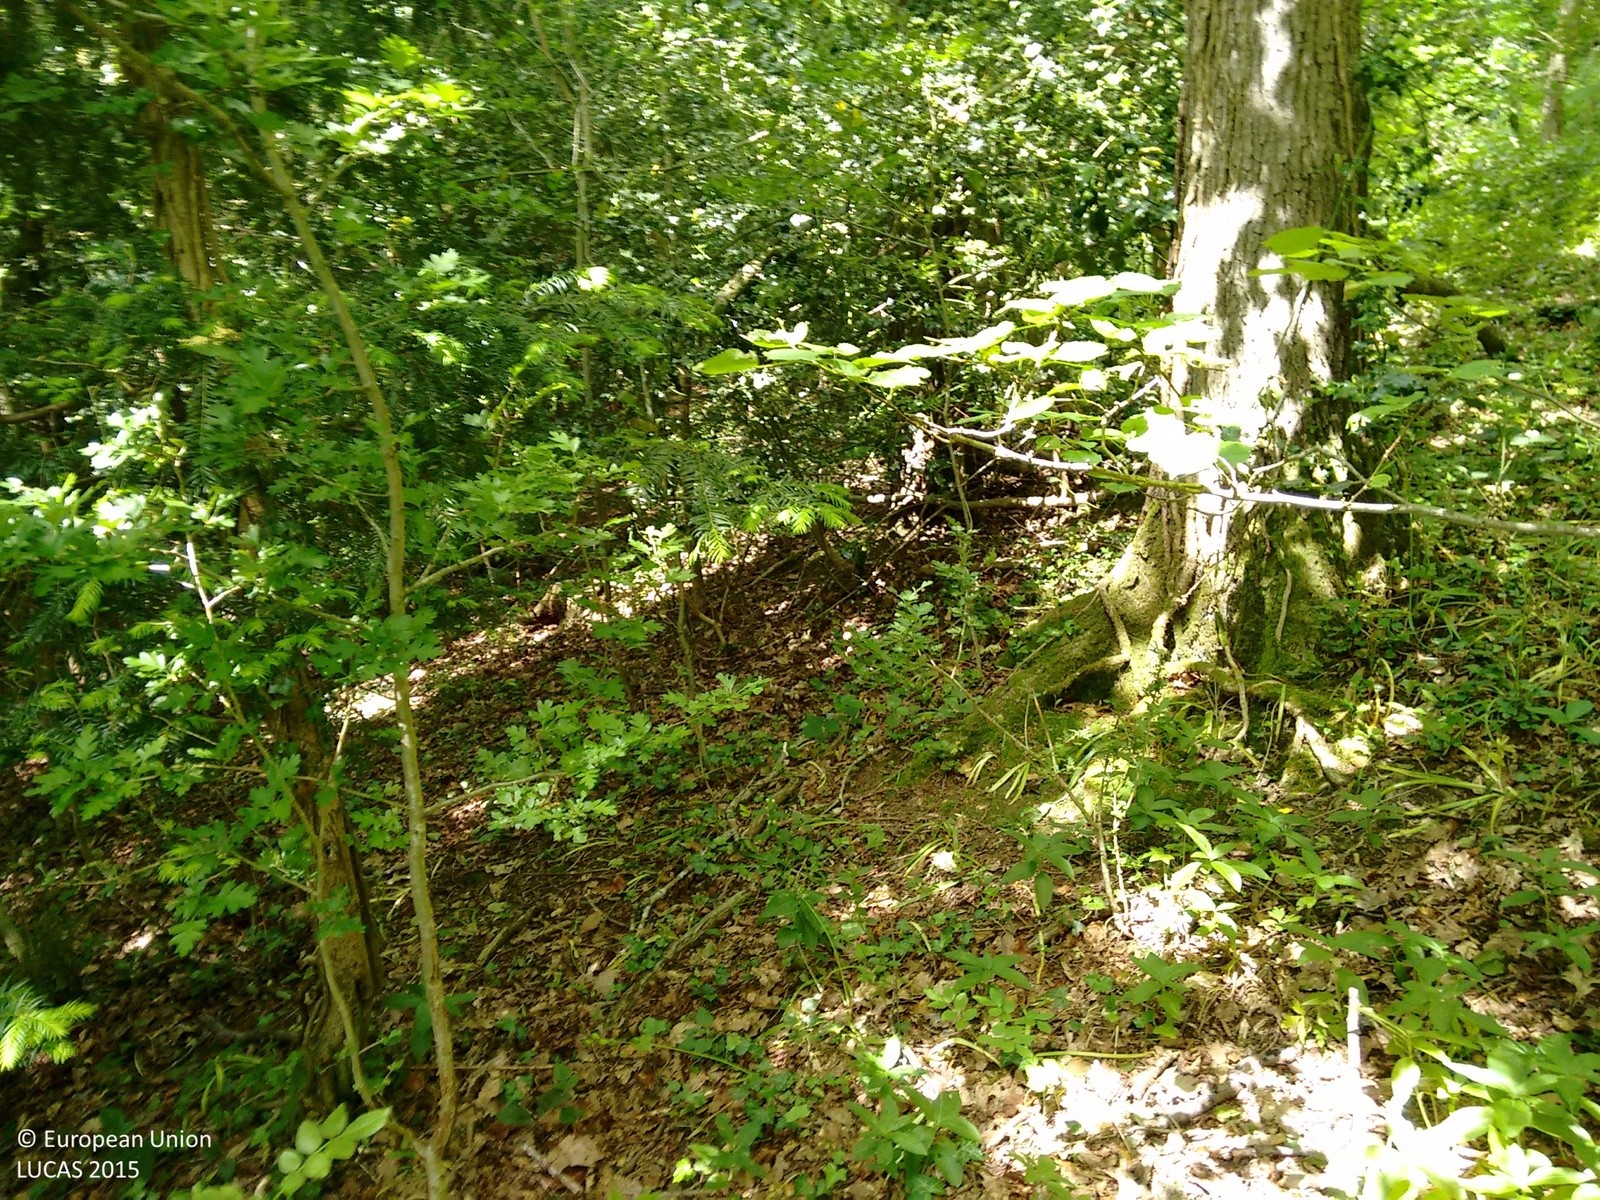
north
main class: Woodland
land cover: Broadleaved woodland
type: mesophytic deciduous forest
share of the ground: > 75 %
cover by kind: broadleaved forest trees 100 %
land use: Semi-natural and natural areas not in use
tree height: > 5 m
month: June
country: GB
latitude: 52.1445
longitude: -2.3833
